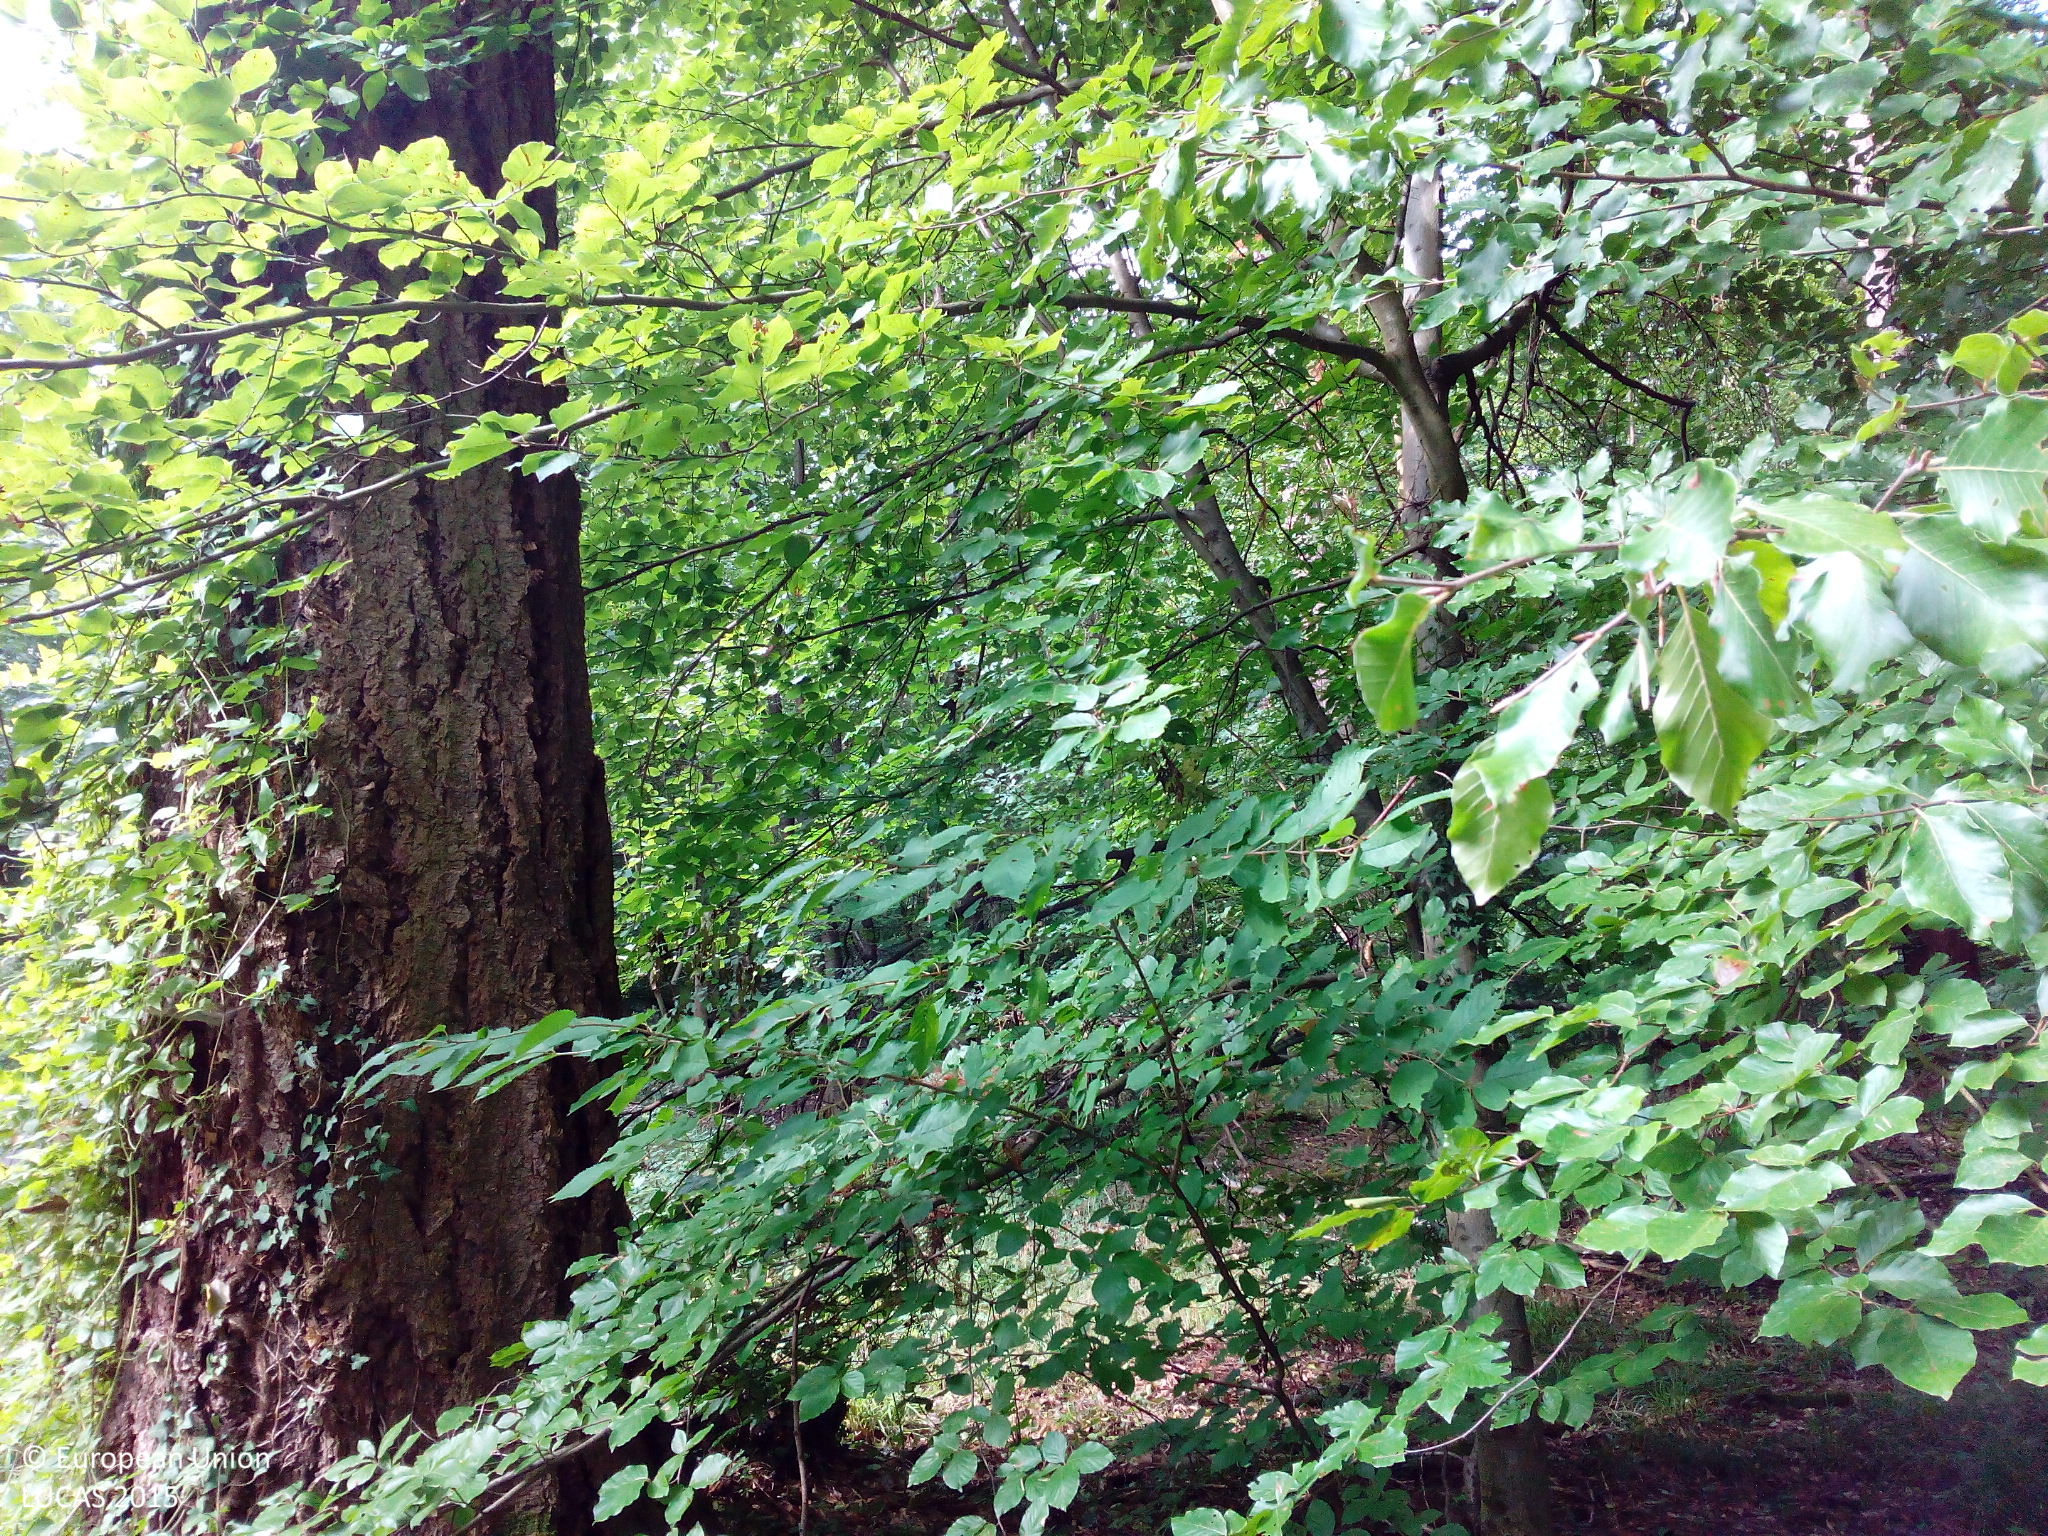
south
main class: Woodland
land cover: Pine dominated mixed woodland
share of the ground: > 75 %
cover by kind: broadleaved forest trees 65 %, coniferous forest trees 25 %, herbaceous plants 5 %, unconsolidated bare surface 5 %
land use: Forestry
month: August
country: DE
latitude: 49.0253
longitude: 8.6740
